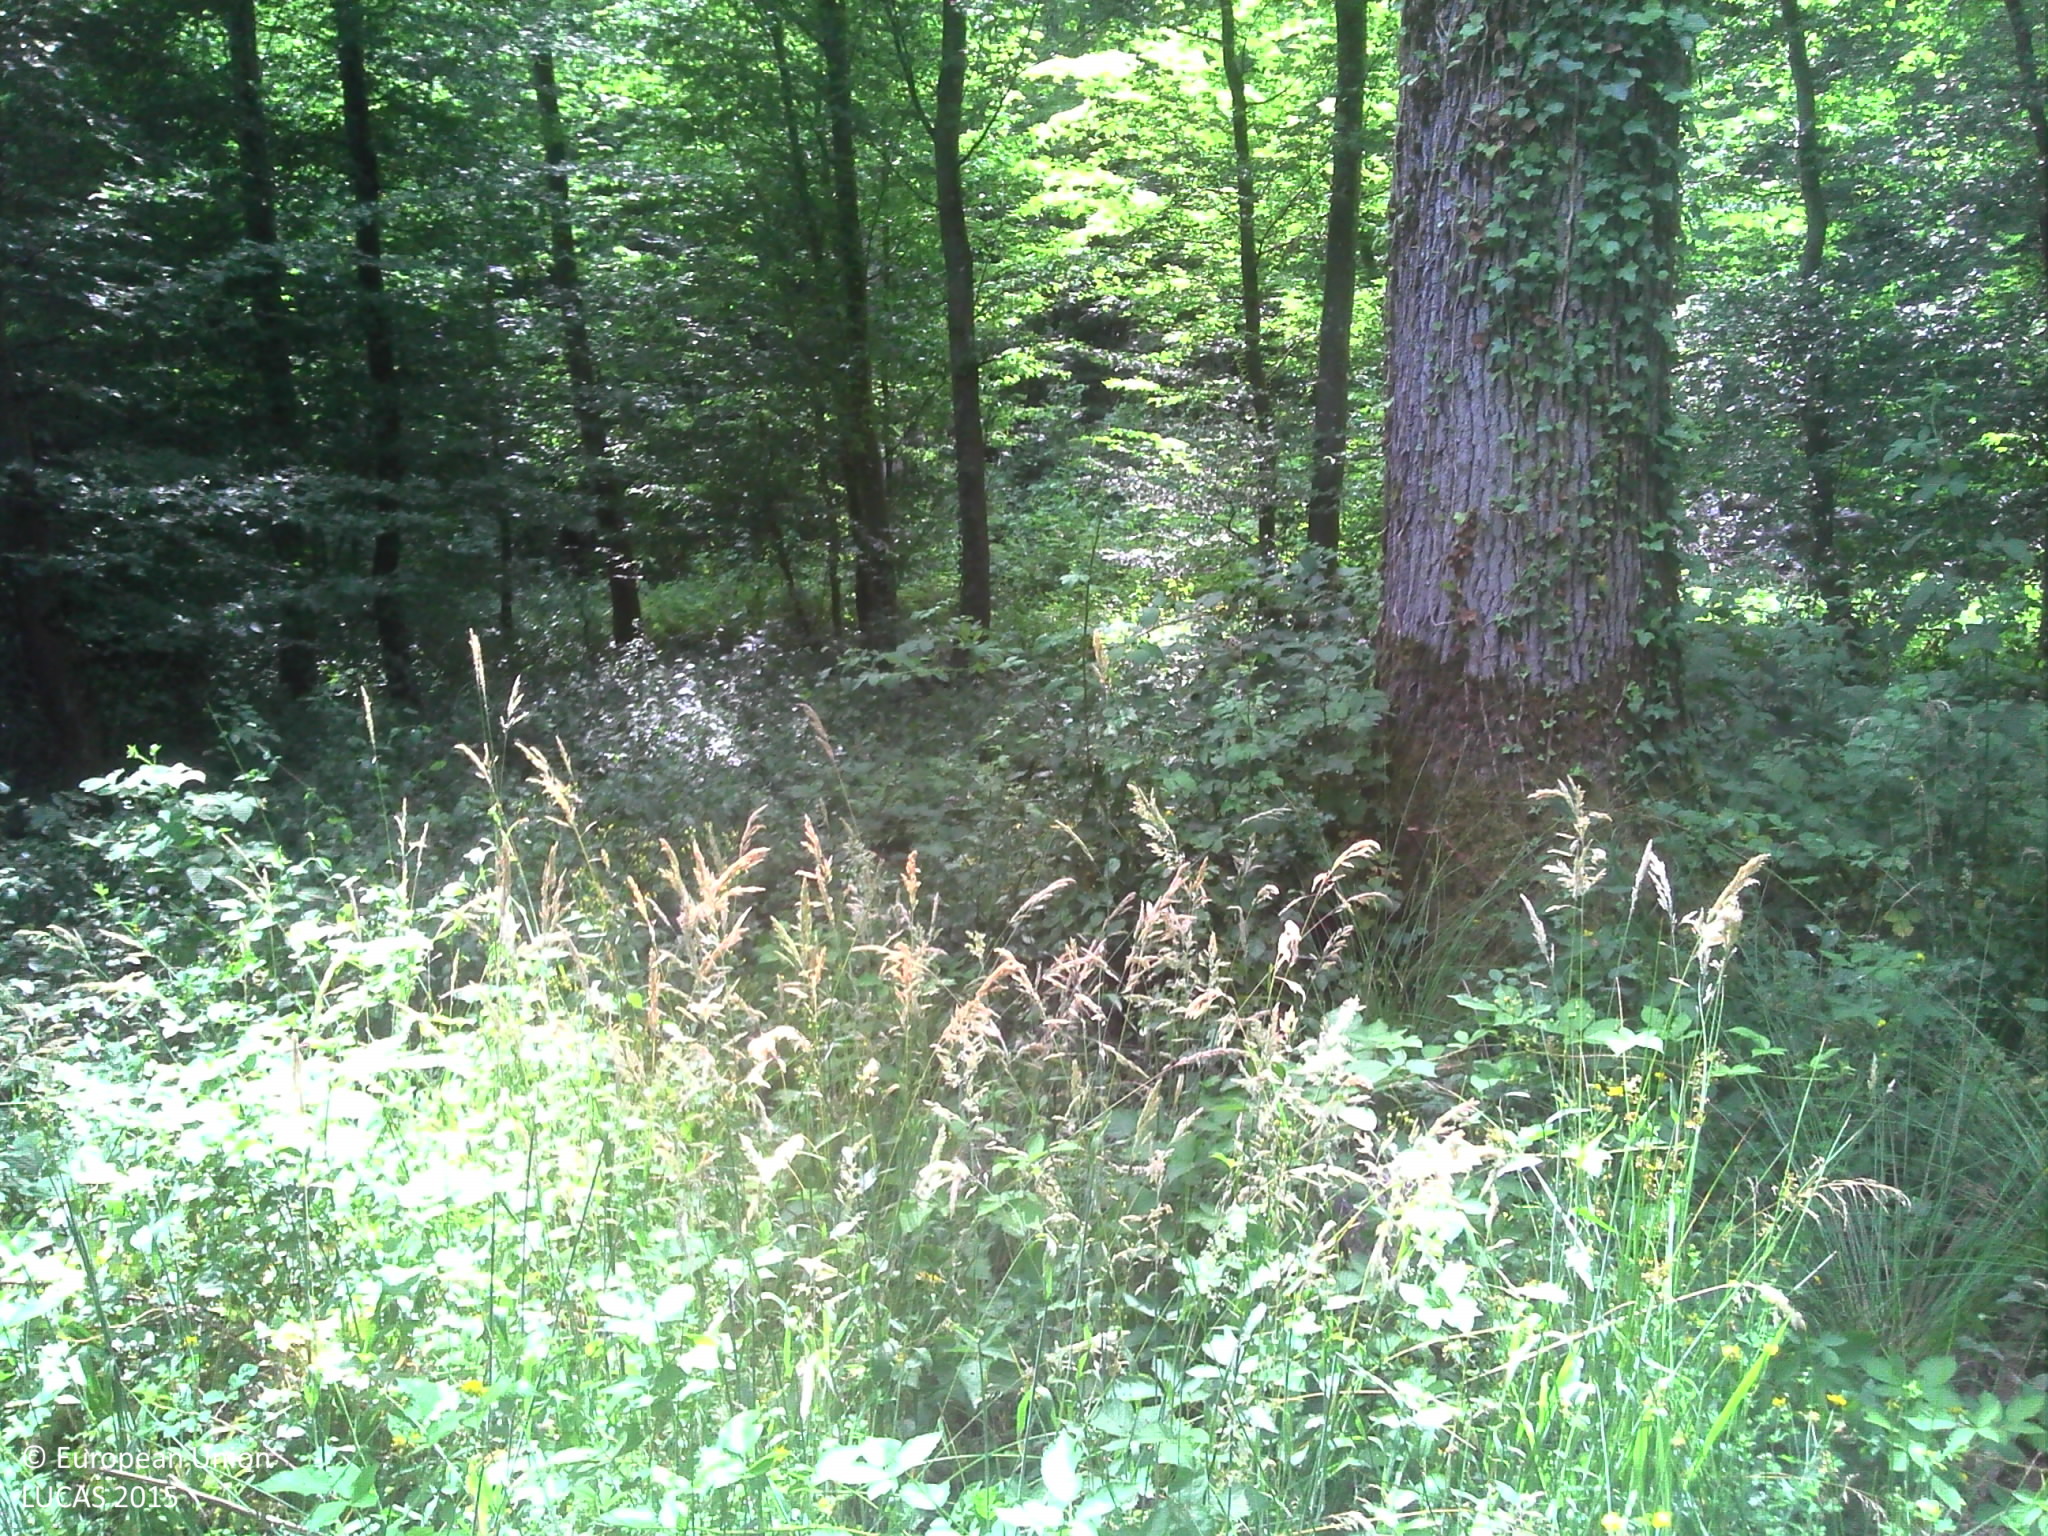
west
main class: Woodland
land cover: Broadleaved woodland
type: mesophytic deciduous forest
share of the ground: > 75 %
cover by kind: broadleaved forest trees 80 %, herbaceous plants 20 %
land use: Forestry
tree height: > 5 m
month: June
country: FR
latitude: 46.6765
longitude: 4.8116
